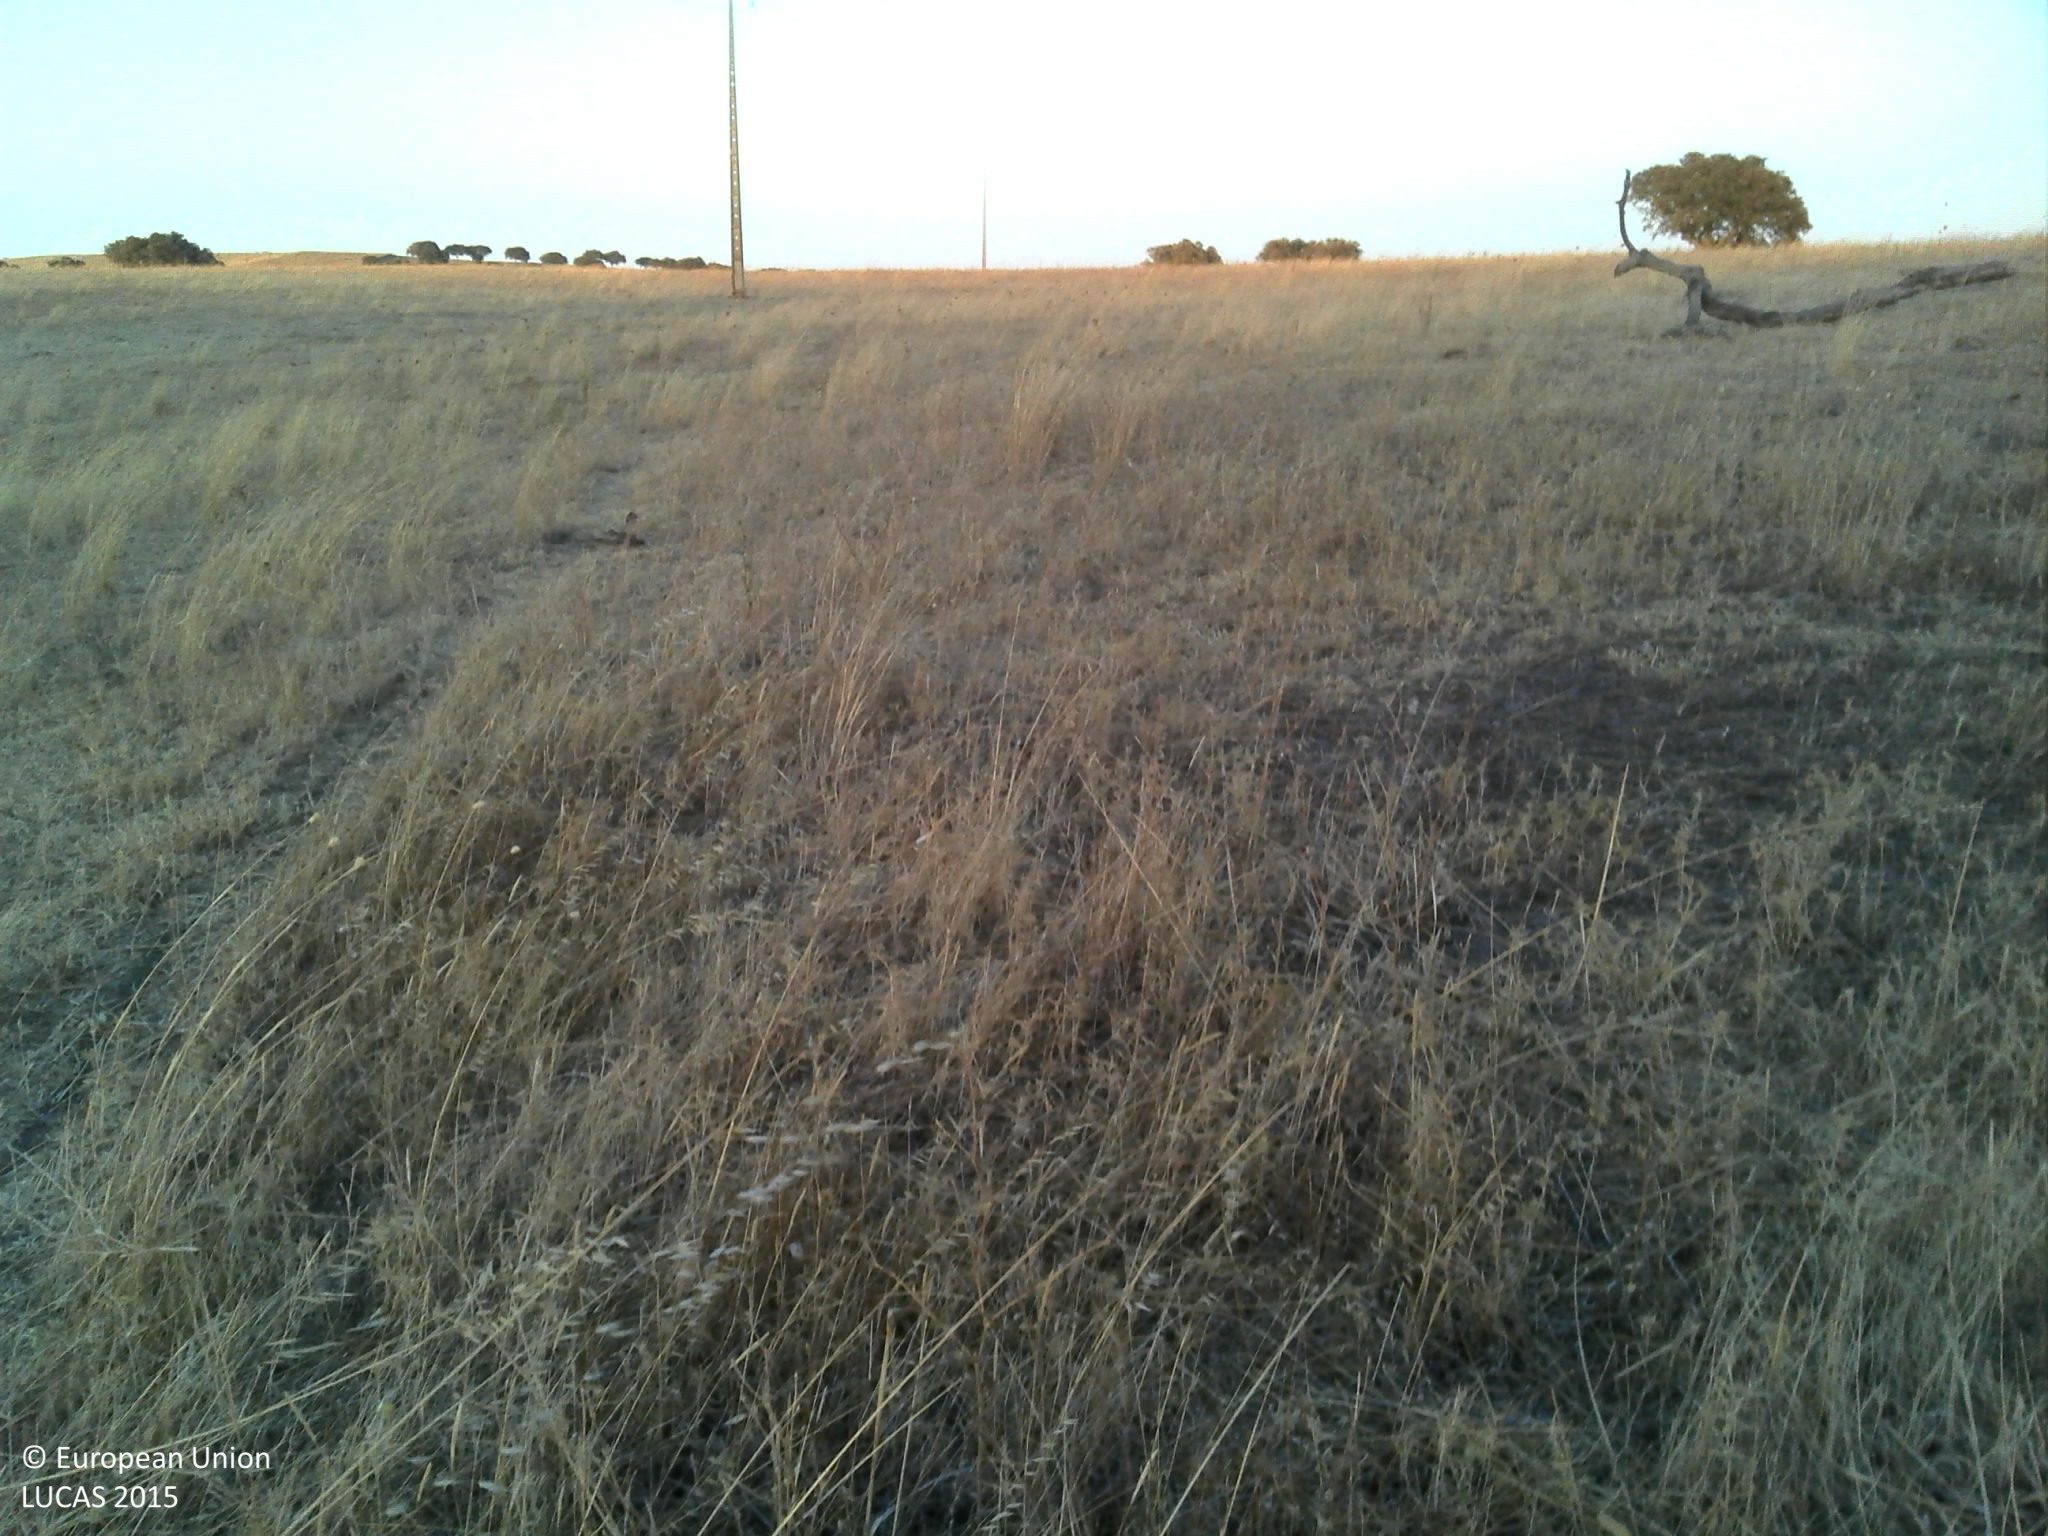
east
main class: Grassland
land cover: Grassland without tree/shrub cover
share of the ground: 50 - 75 %
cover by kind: herbaceous plants 60 %, unconsolidated bare surface 40 %
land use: Agriculture (excluding fallow land and kitchen gardens)
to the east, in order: Grassland without tree/shrub cover
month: July
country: PT
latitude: 38.2338
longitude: -7.9123
